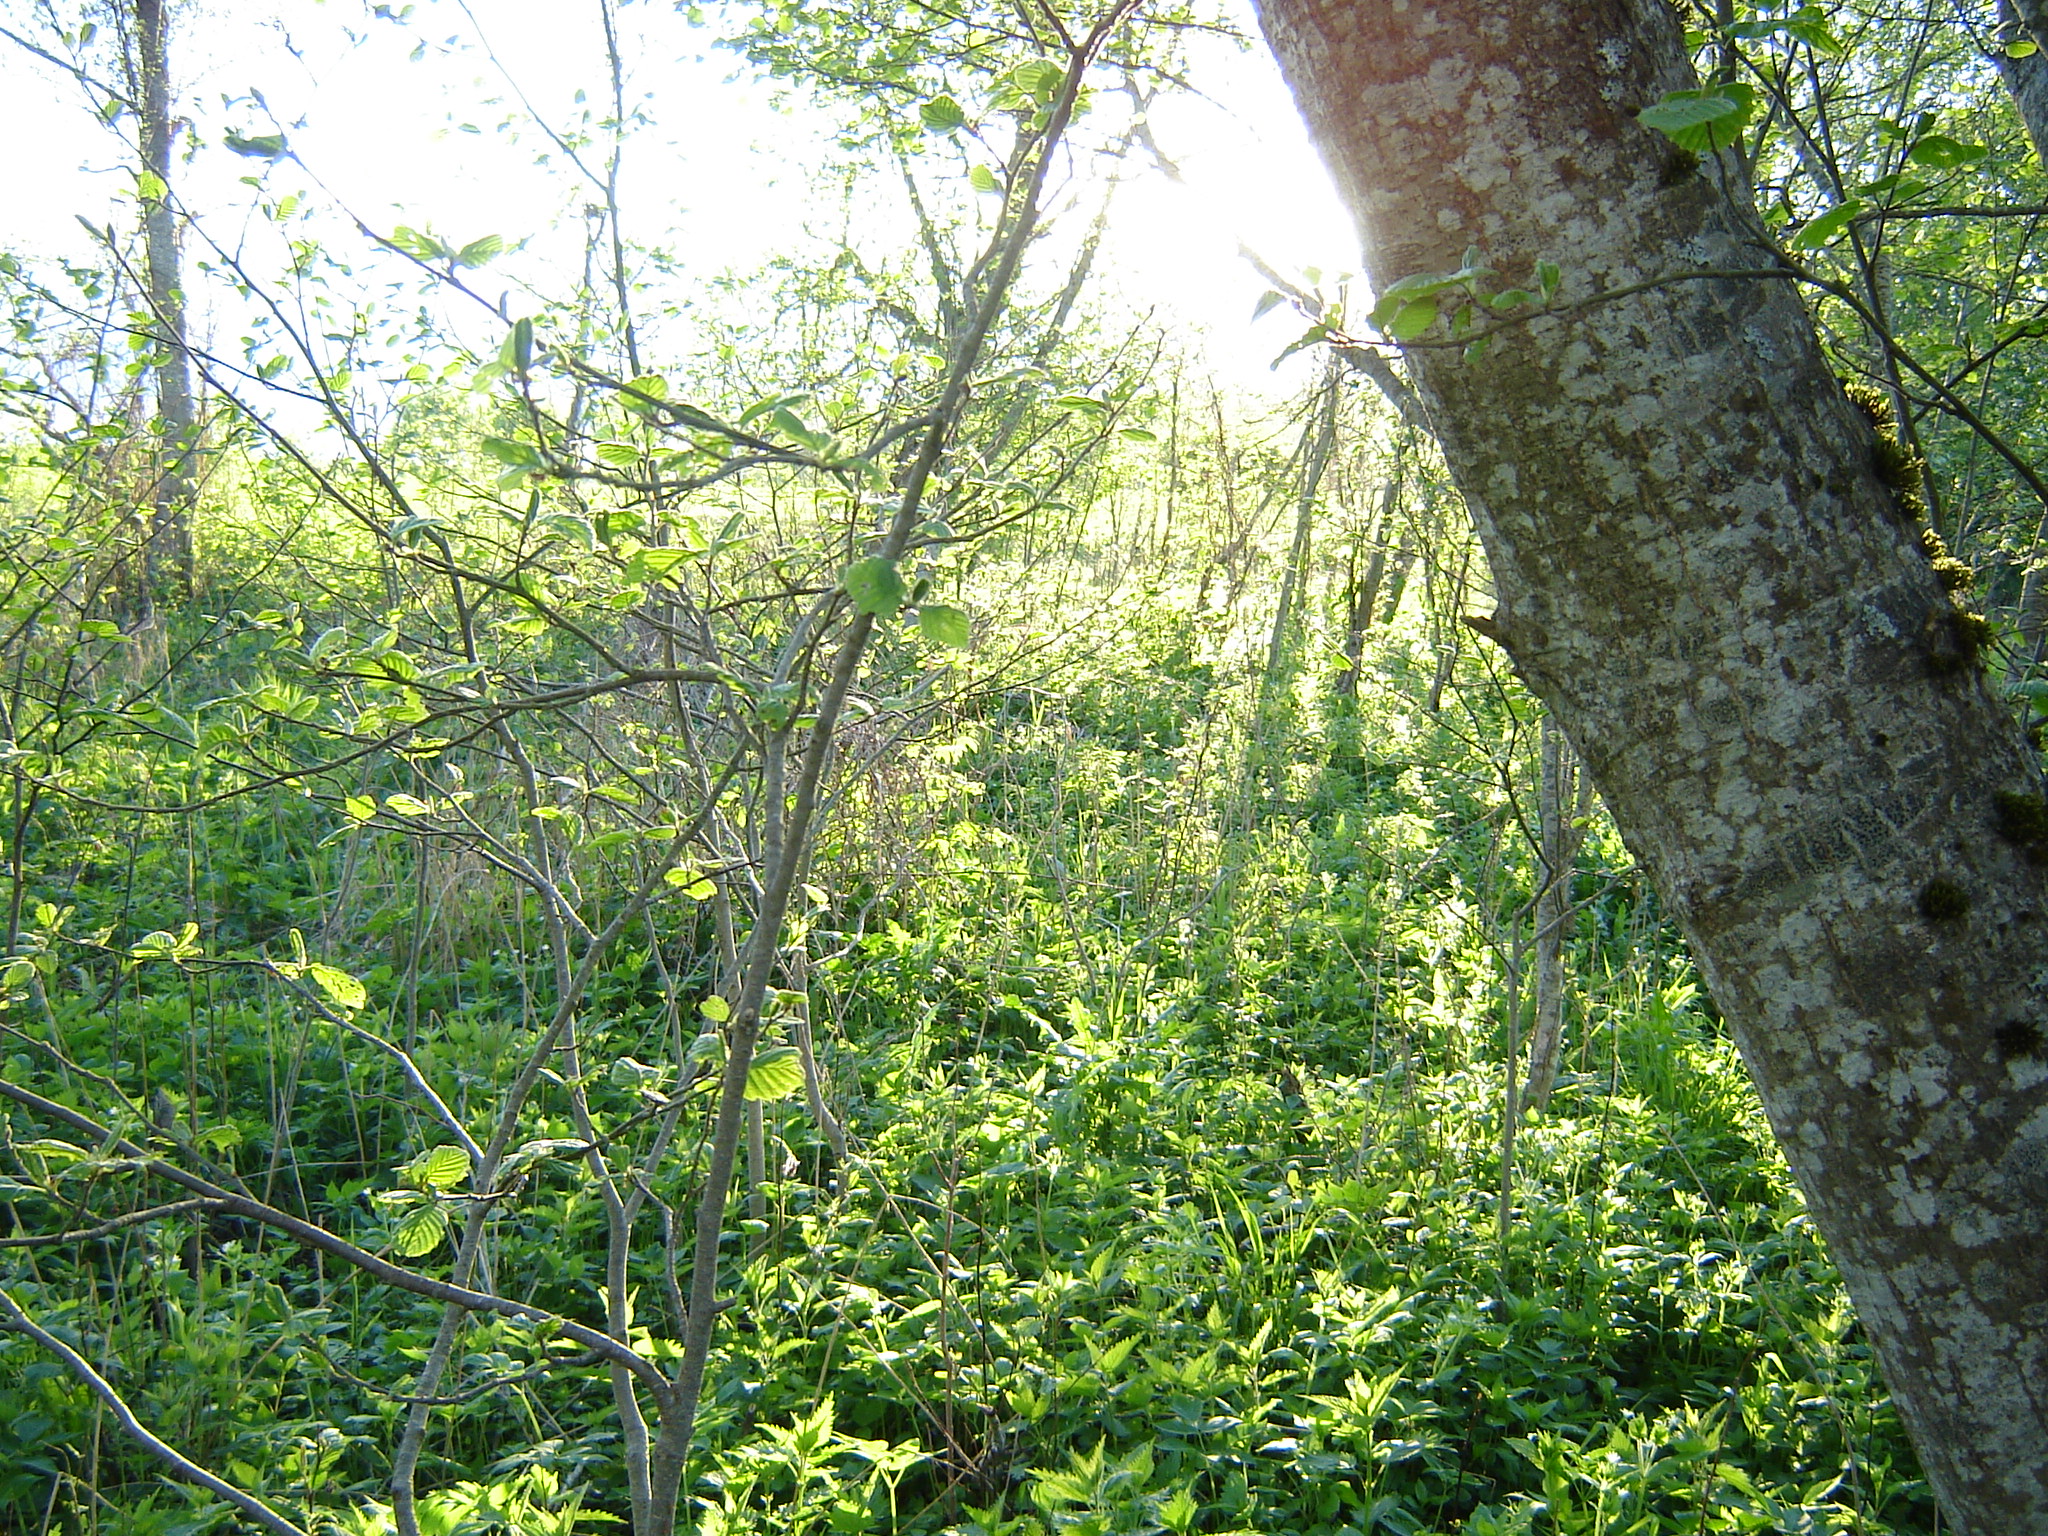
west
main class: Woodland
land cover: Broadleaved woodland
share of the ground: > 75 %
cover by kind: broadleaved forest trees 80 %, herbaceous plants 20 %
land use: Forestry
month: May
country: LT
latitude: 56.0734
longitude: 25.2656
